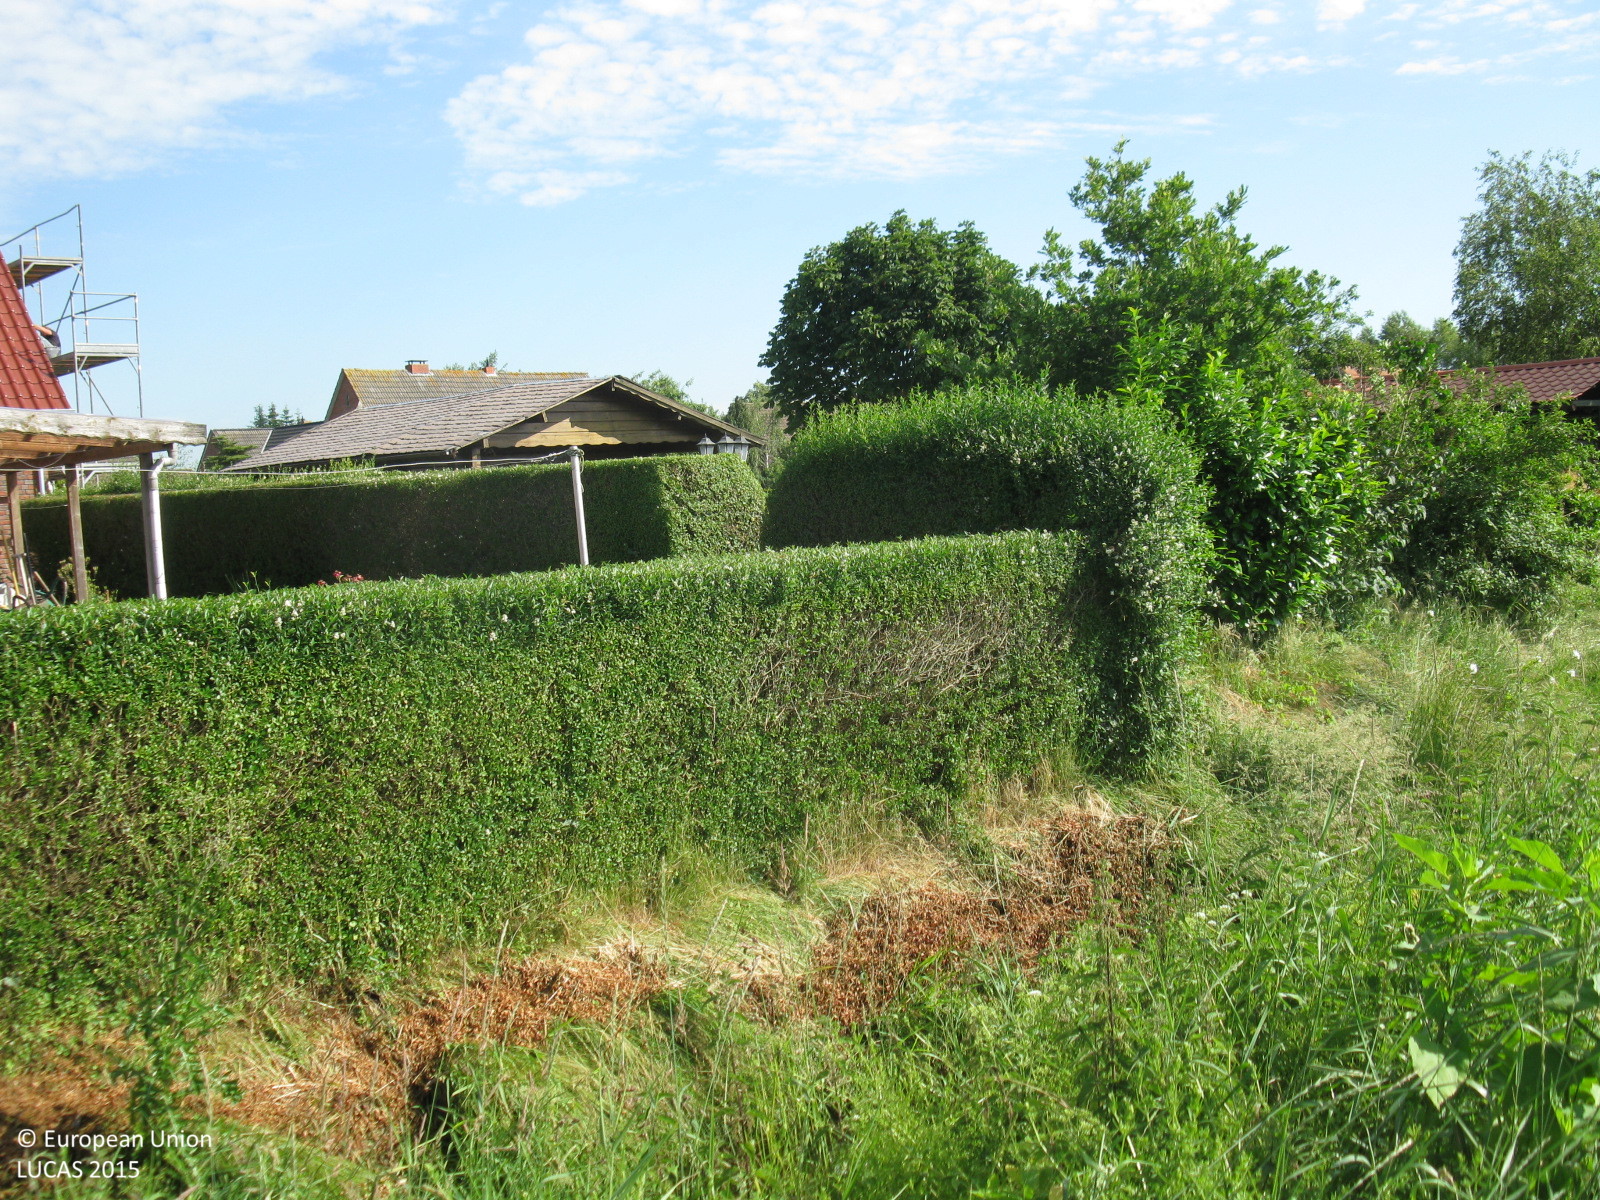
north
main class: Grassland
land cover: Grassland without tree/shrub cover
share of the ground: > 75 %
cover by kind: herbaceous plants 100 %
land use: Agriculture (excluding fallow land and kitchen gardens)
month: July
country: DE
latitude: 53.4639
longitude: 7.3948
